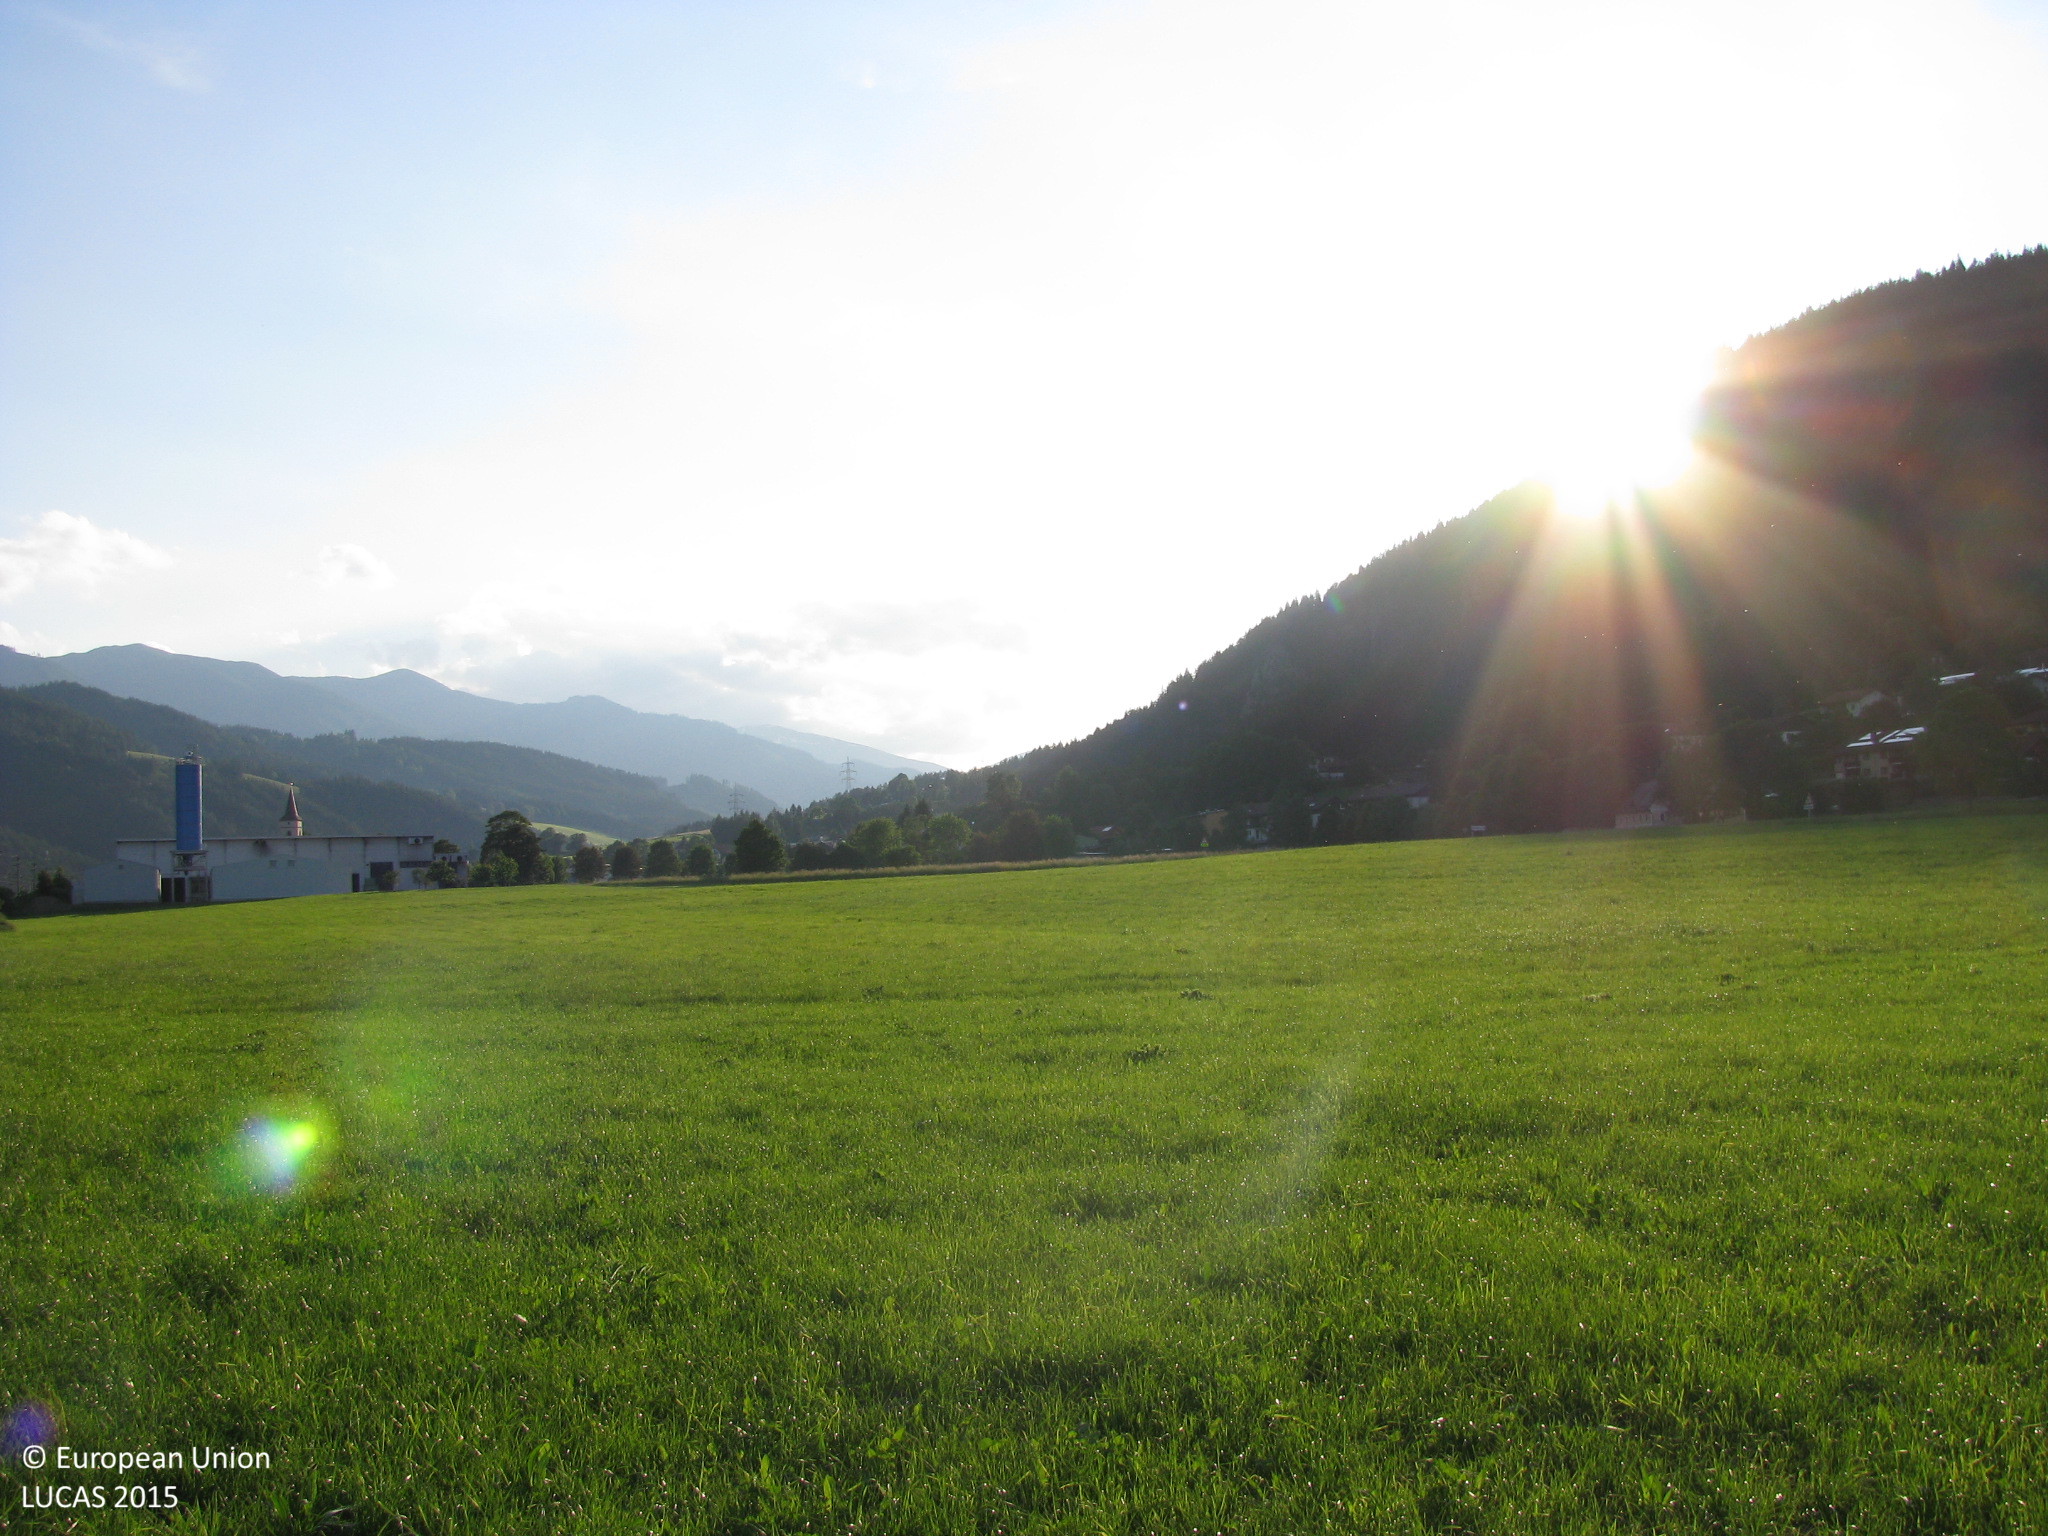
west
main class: Grassland
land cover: Grassland without tree/shrub cover
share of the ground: > 75 %
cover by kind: herbaceous plants 100 %
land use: Agriculture (excluding fallow land and kitchen gardens)
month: June
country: AT
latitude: 47.3927
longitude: 14.9147
